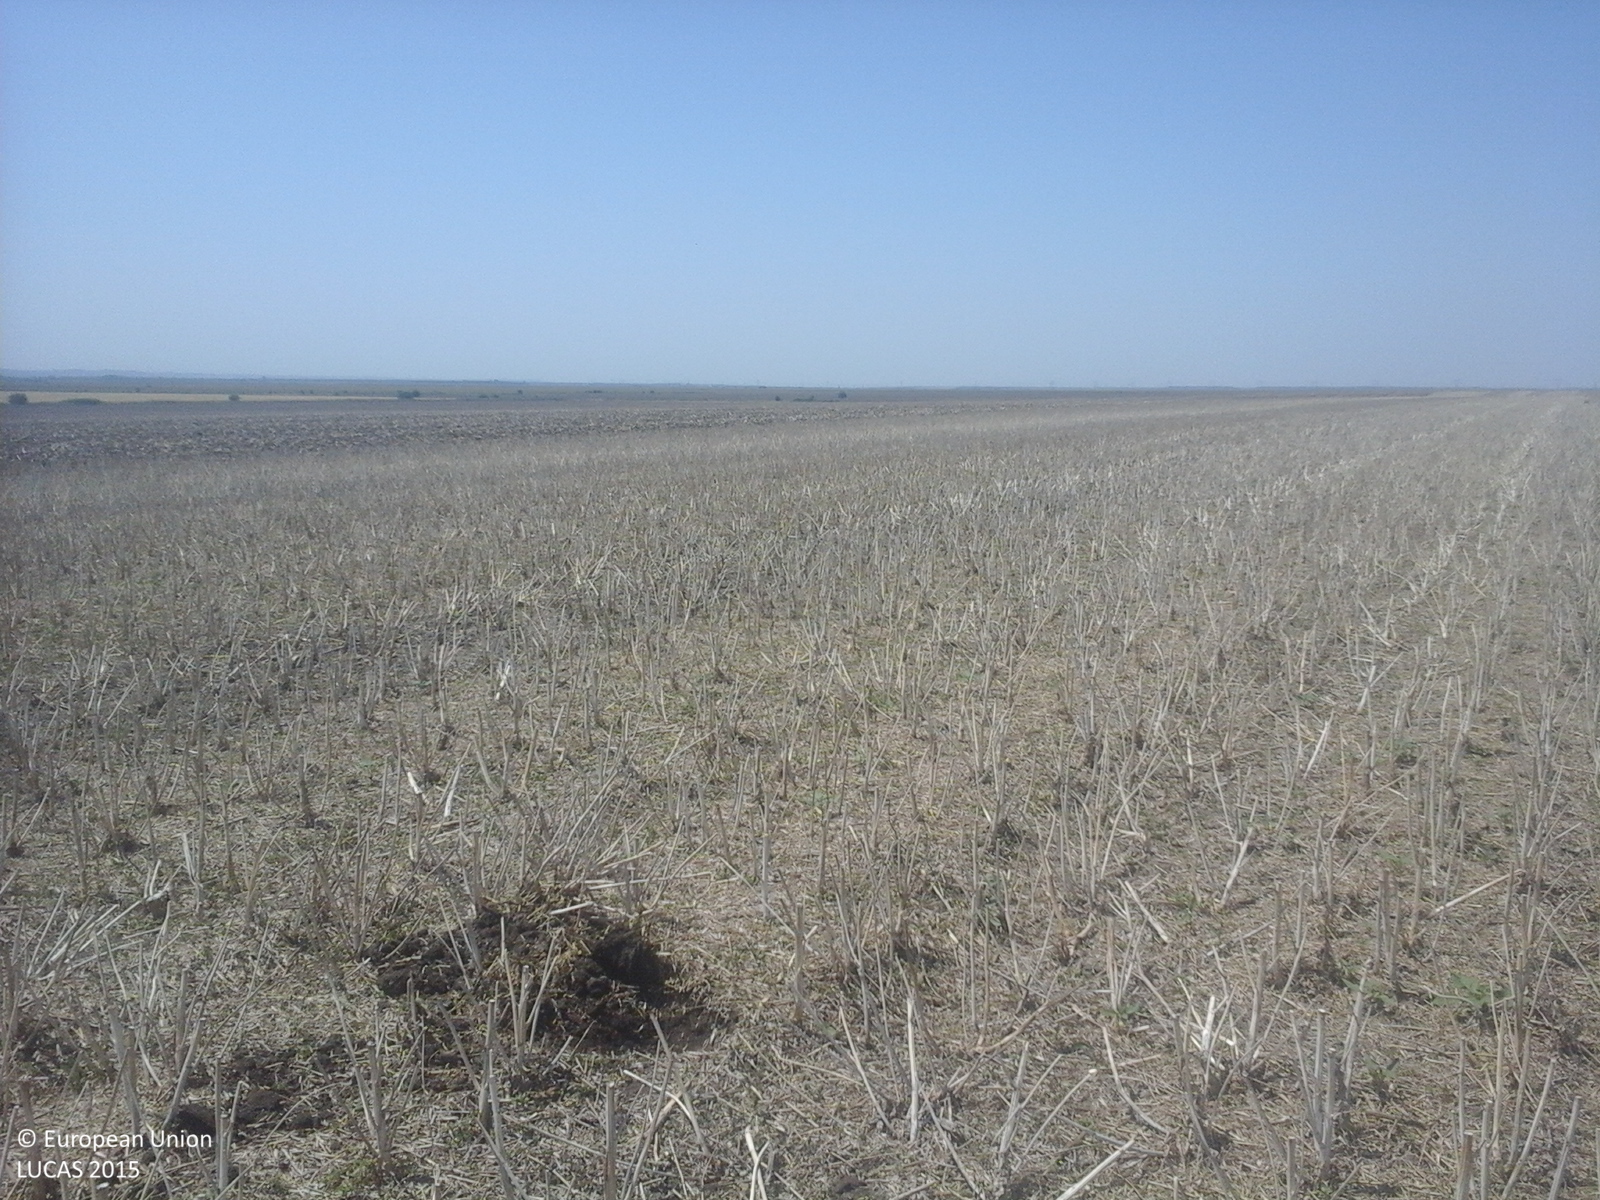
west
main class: Cropland
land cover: Rape and turnip rape
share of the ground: 10 - 25 %
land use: Agriculture (excluding fallow land and kitchen gardens)
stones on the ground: < 10 %
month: July
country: RO
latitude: 44.2492
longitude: 27.1752
